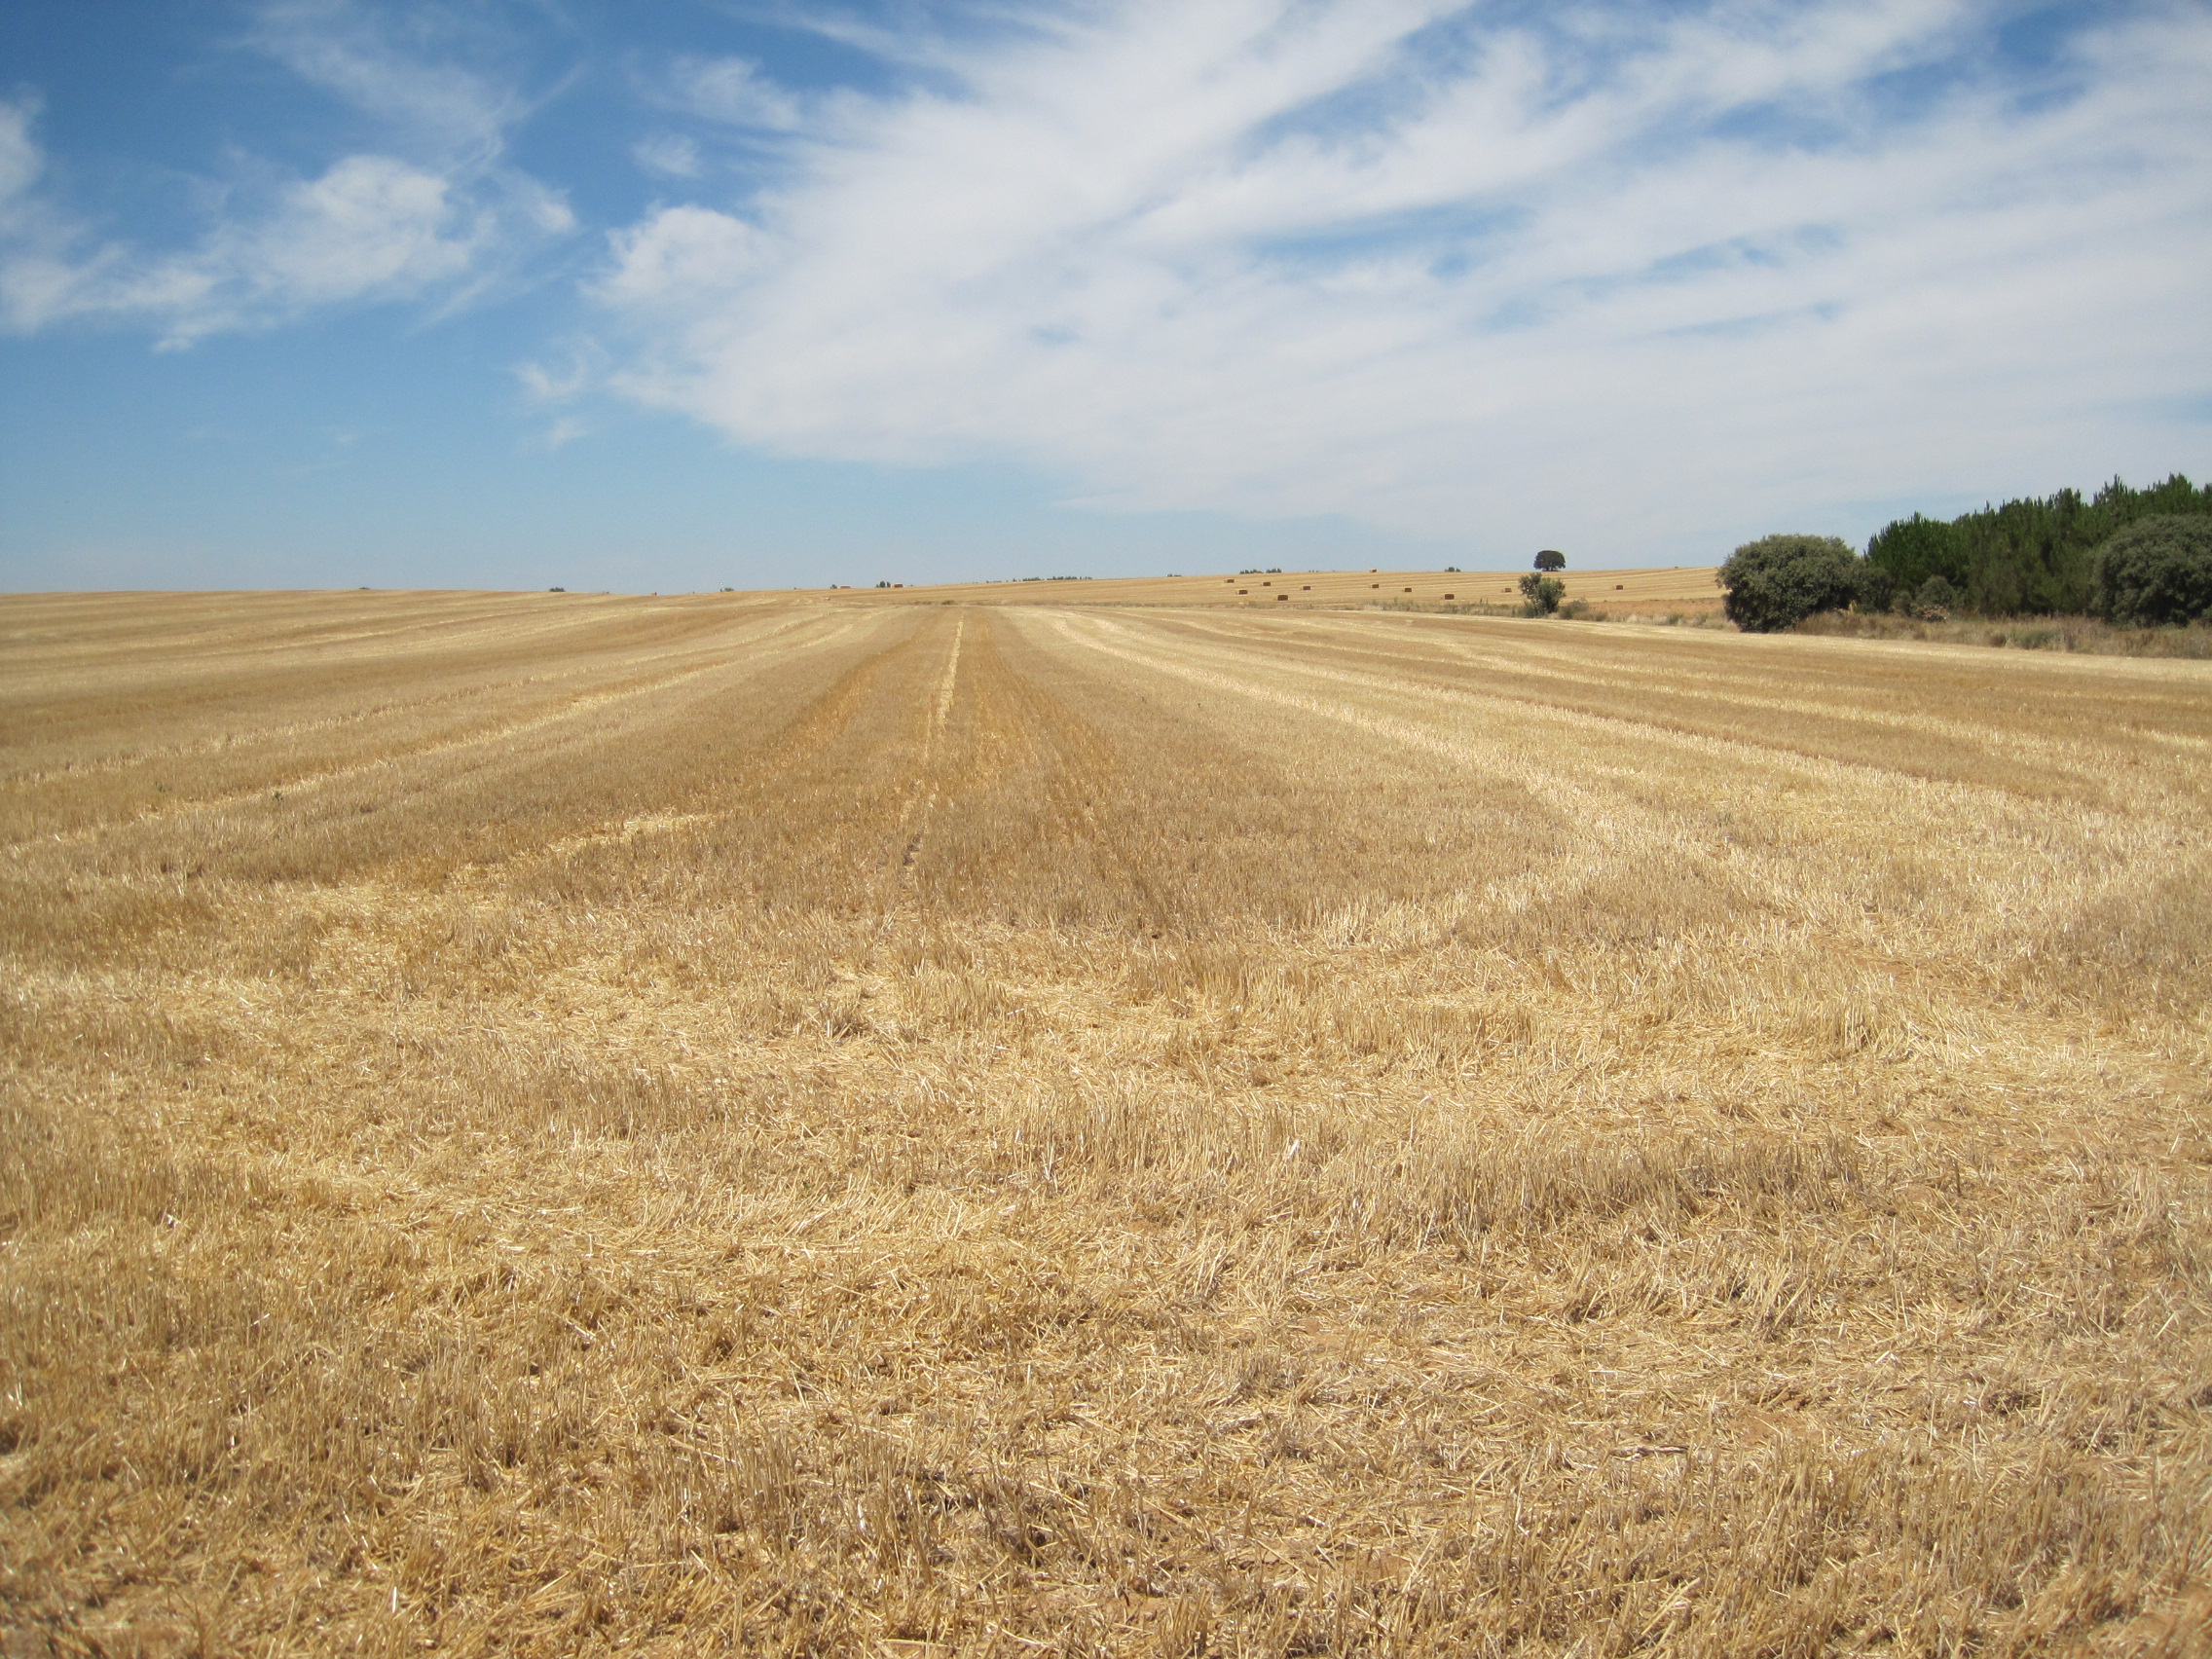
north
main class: Cropland
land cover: Barley
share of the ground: < 10 %
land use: Agriculture (excluding fallow land and kitchen gardens)
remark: Harvested field
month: July
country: ES
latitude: 42.1423
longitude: -5.6658
